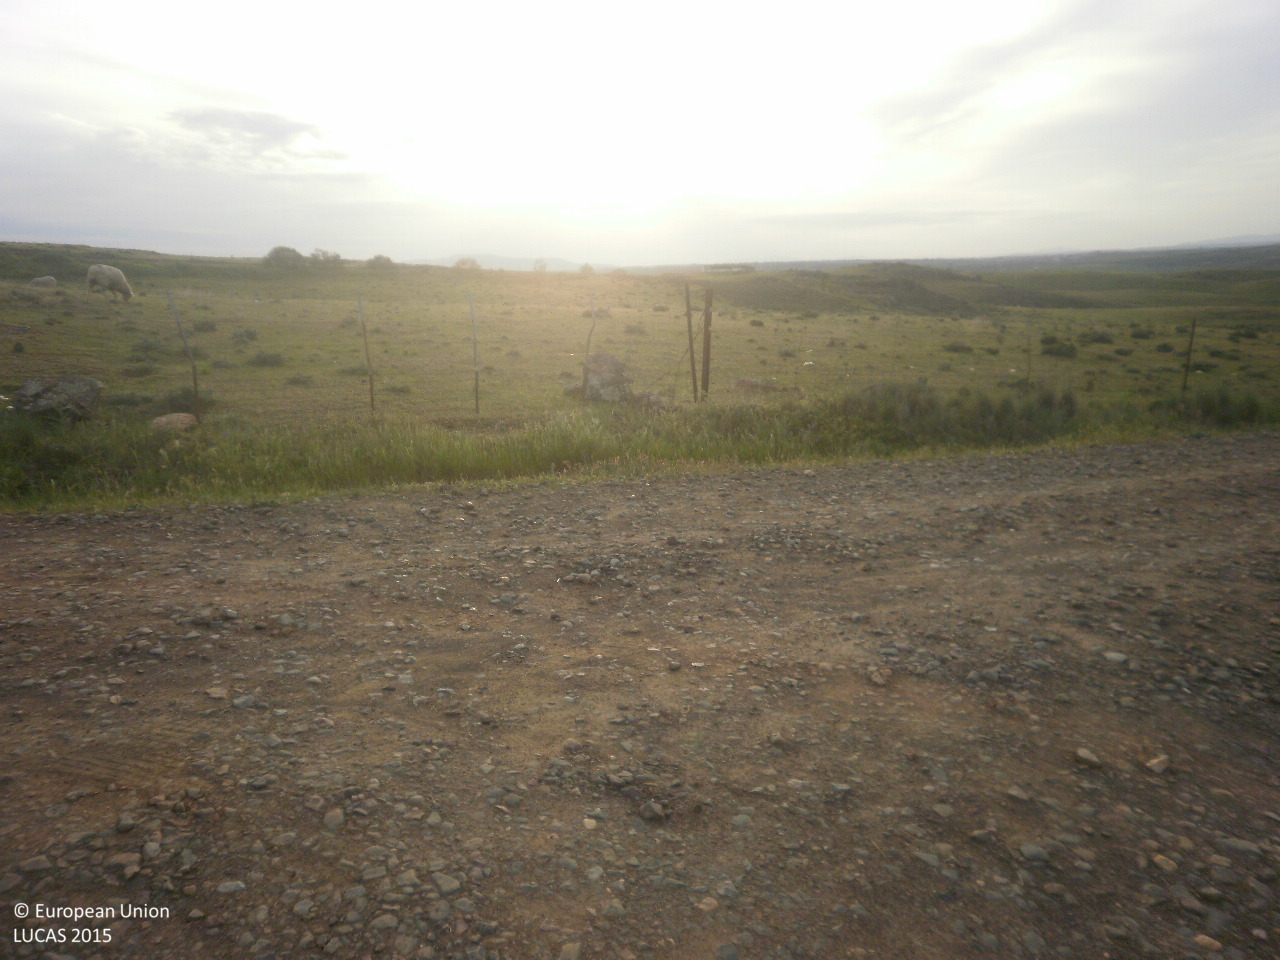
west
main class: Grassland
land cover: Grassland without tree/shrub cover
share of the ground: > 75 %
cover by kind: herbaceous plants 100 %
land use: Agriculture (excluding fallow land and kitchen gardens)
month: April
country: ES
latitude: 39.0831
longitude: -5.2660
